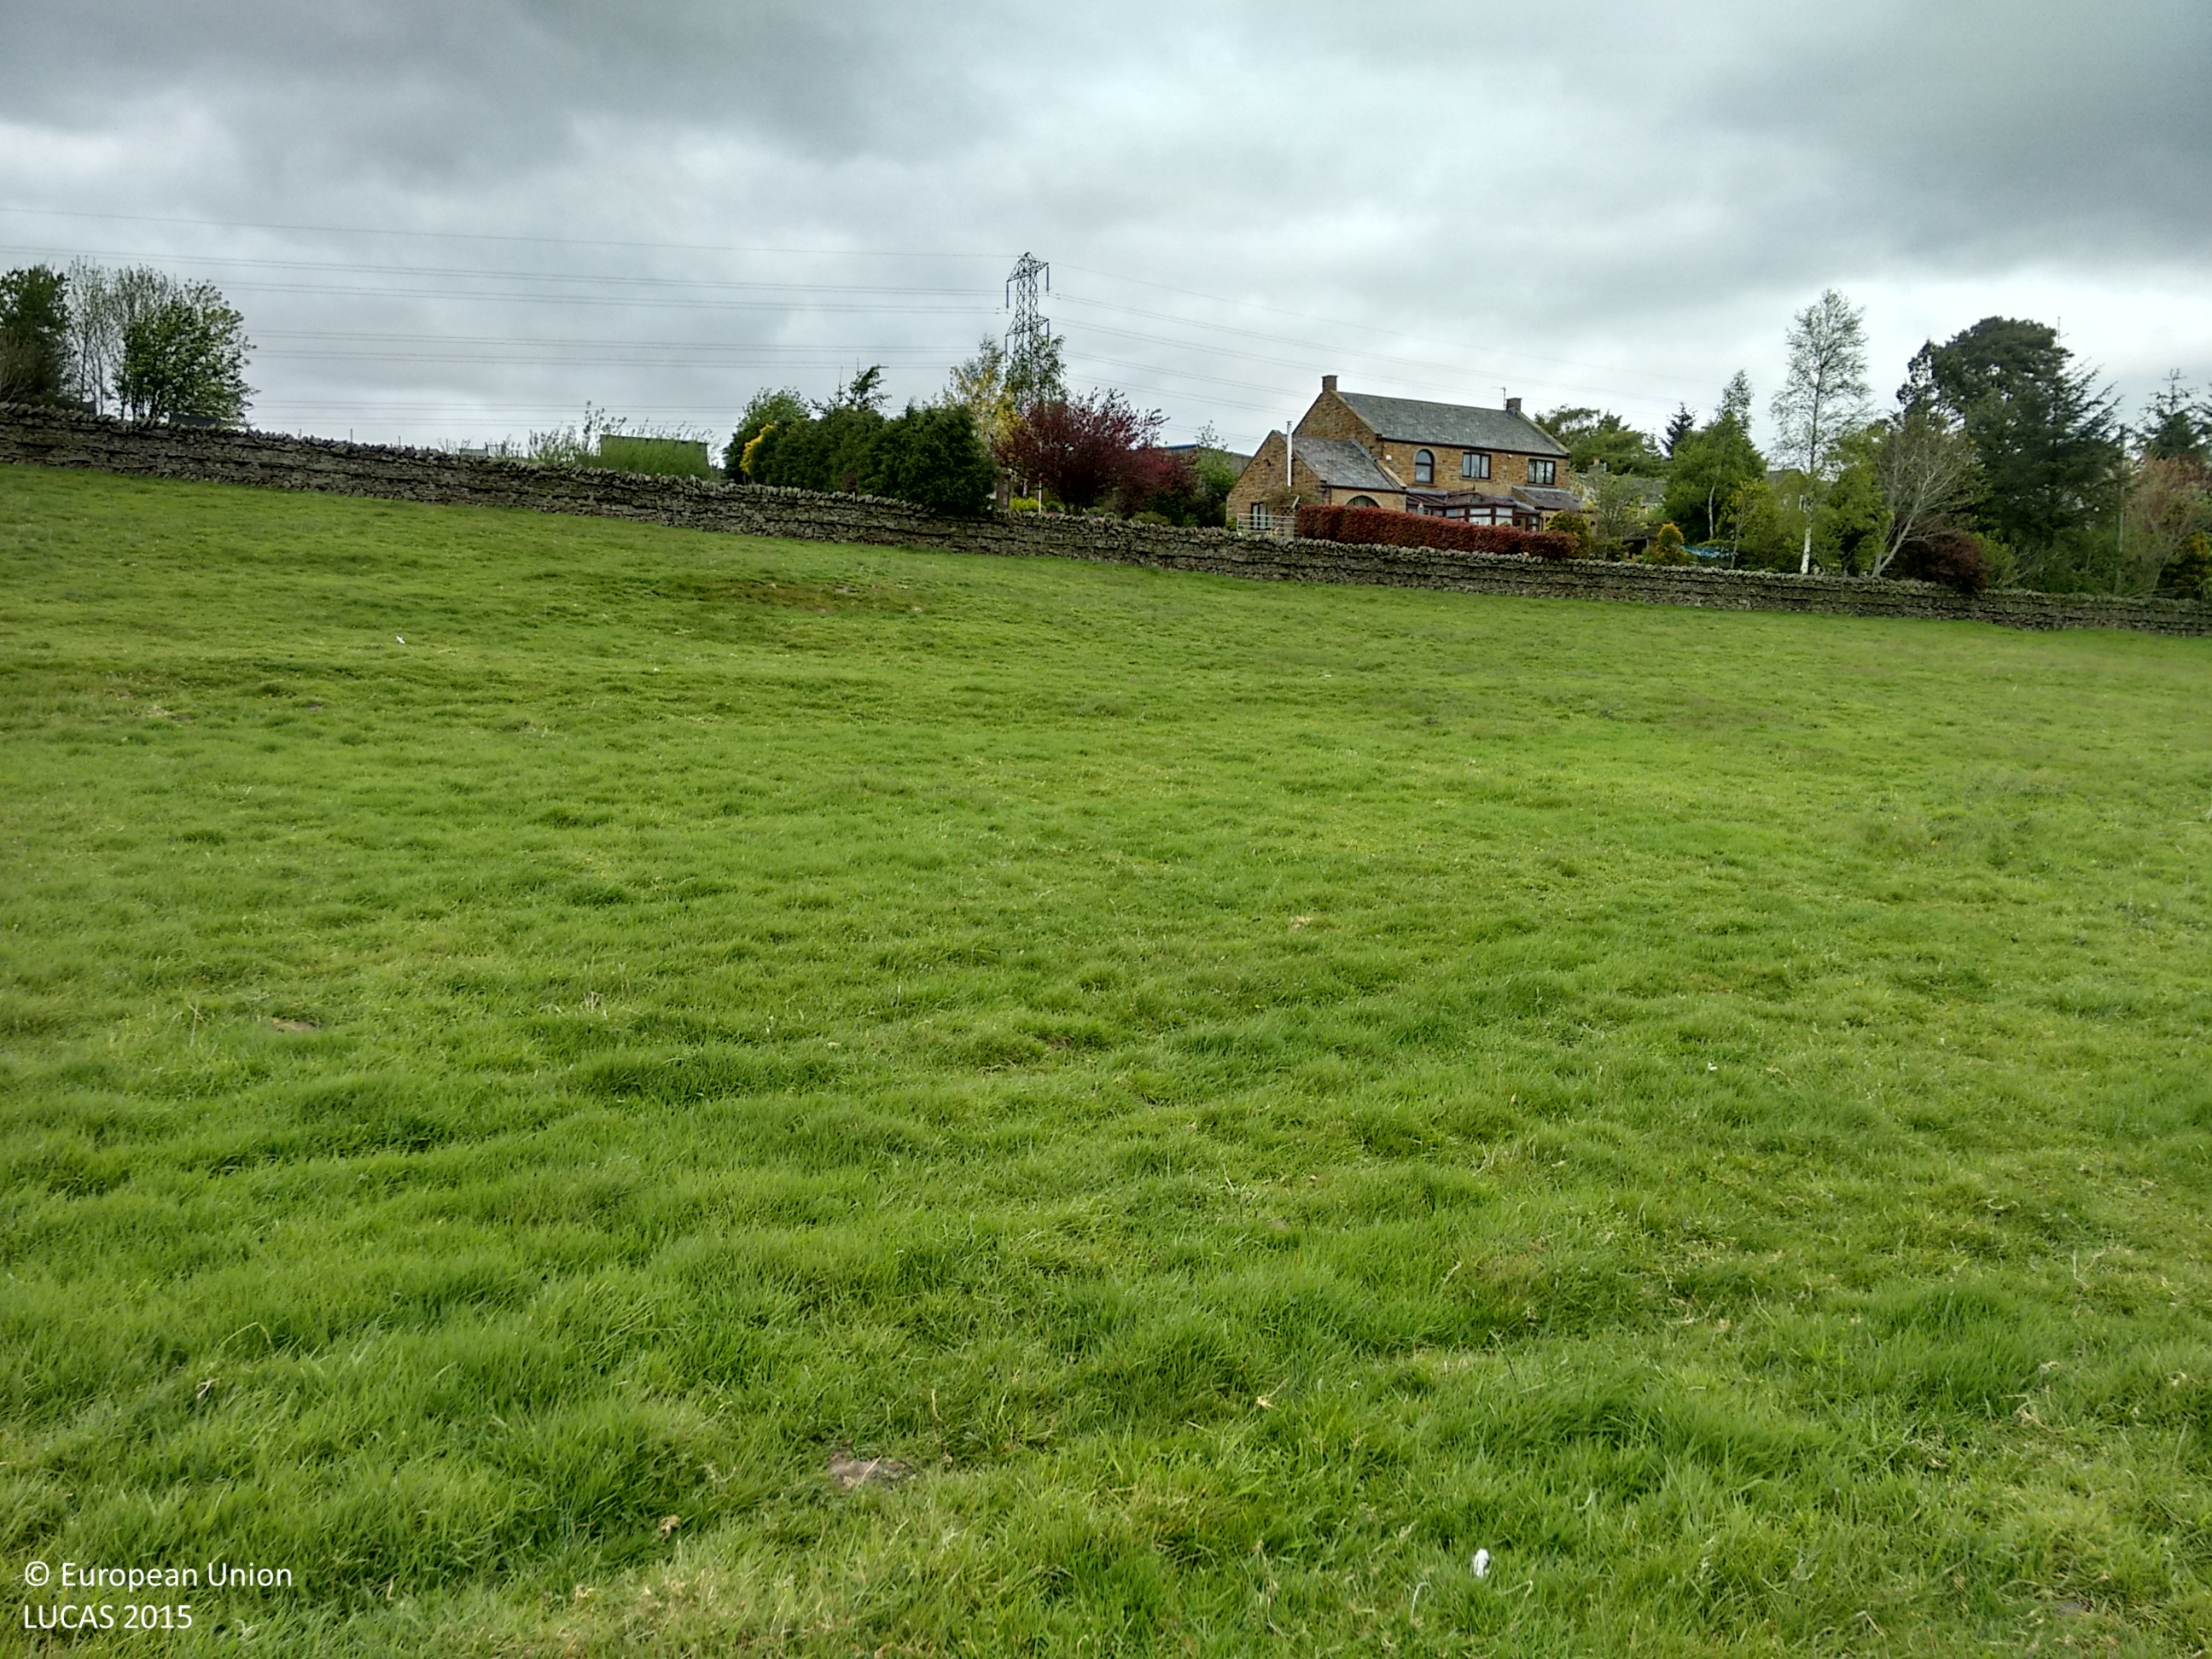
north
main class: Grassland
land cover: Grassland without tree/shrub cover
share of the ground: > 75 %
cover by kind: herbaceous plants 100 %
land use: Agriculture (excluding fallow land and kitchen gardens)
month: May
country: GB
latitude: 54.9773
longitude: -2.4517
